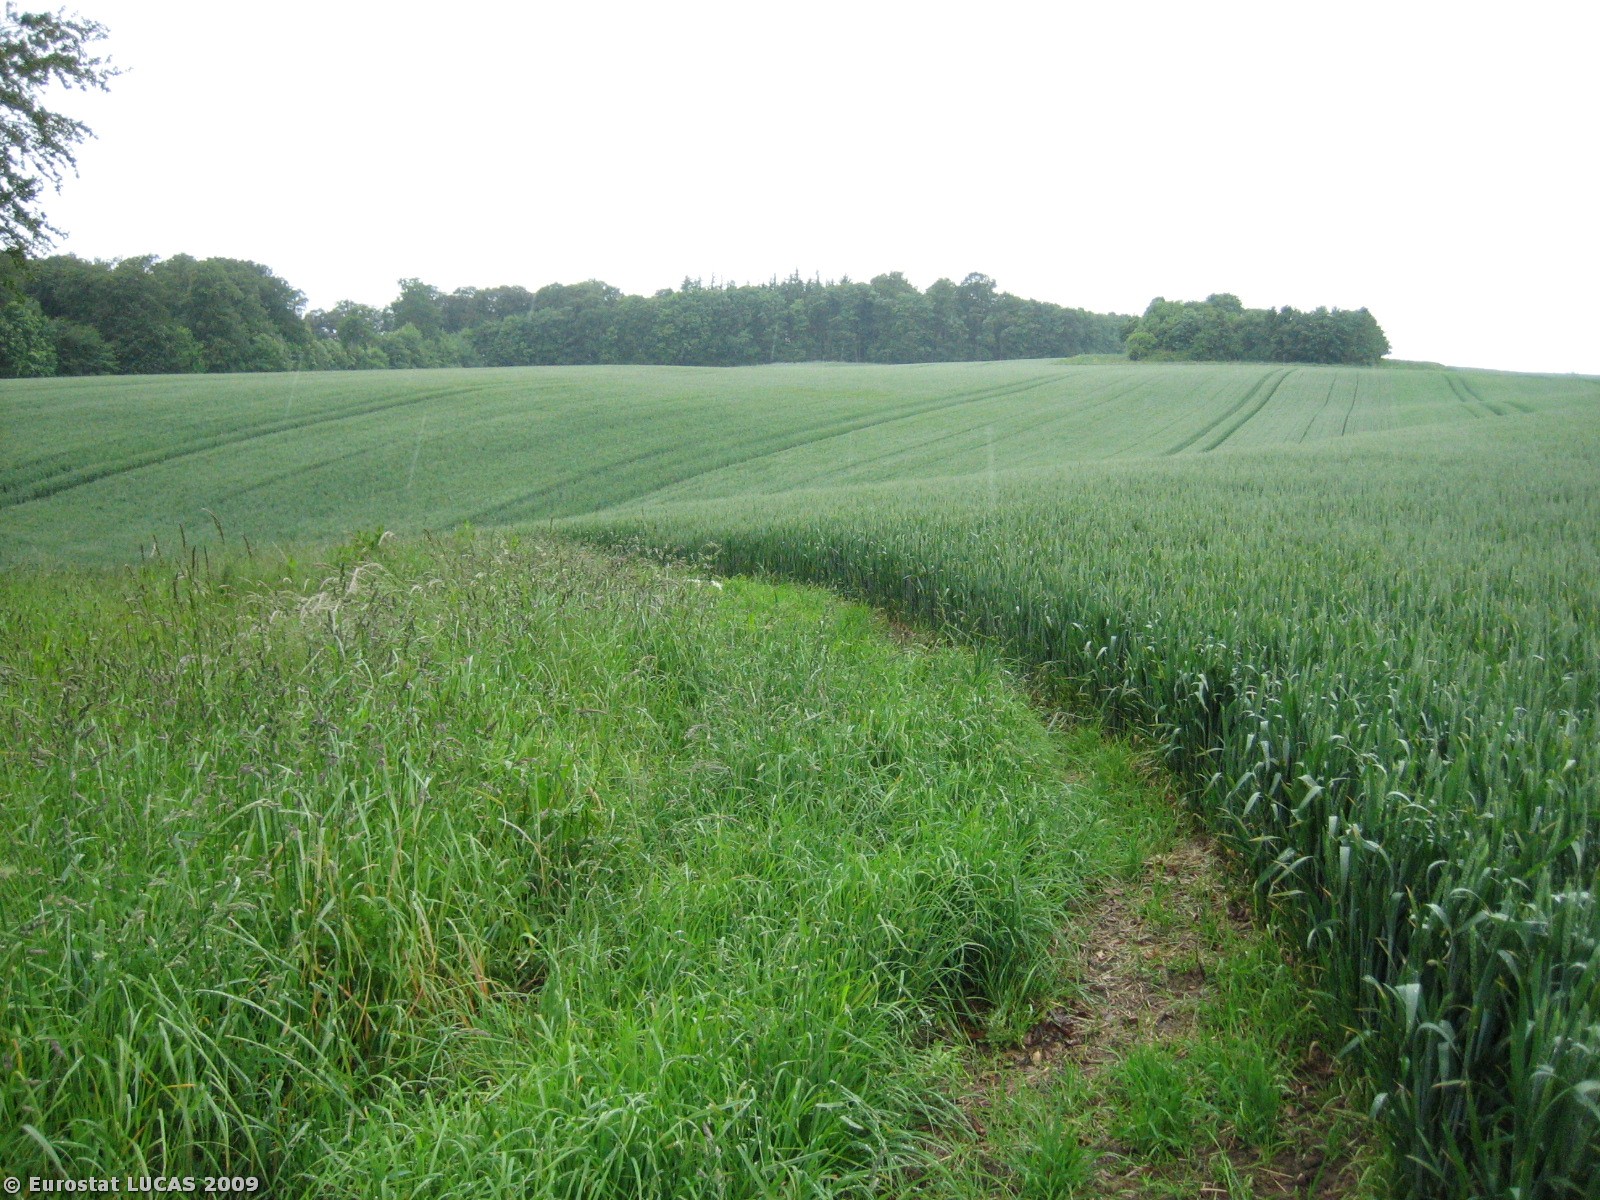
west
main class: Cropland
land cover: Common wheat
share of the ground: > 75 %
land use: Agriculture (excluding fallow land and kitchen gardens)
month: June
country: DK
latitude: 55.9540
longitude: 10.1440
